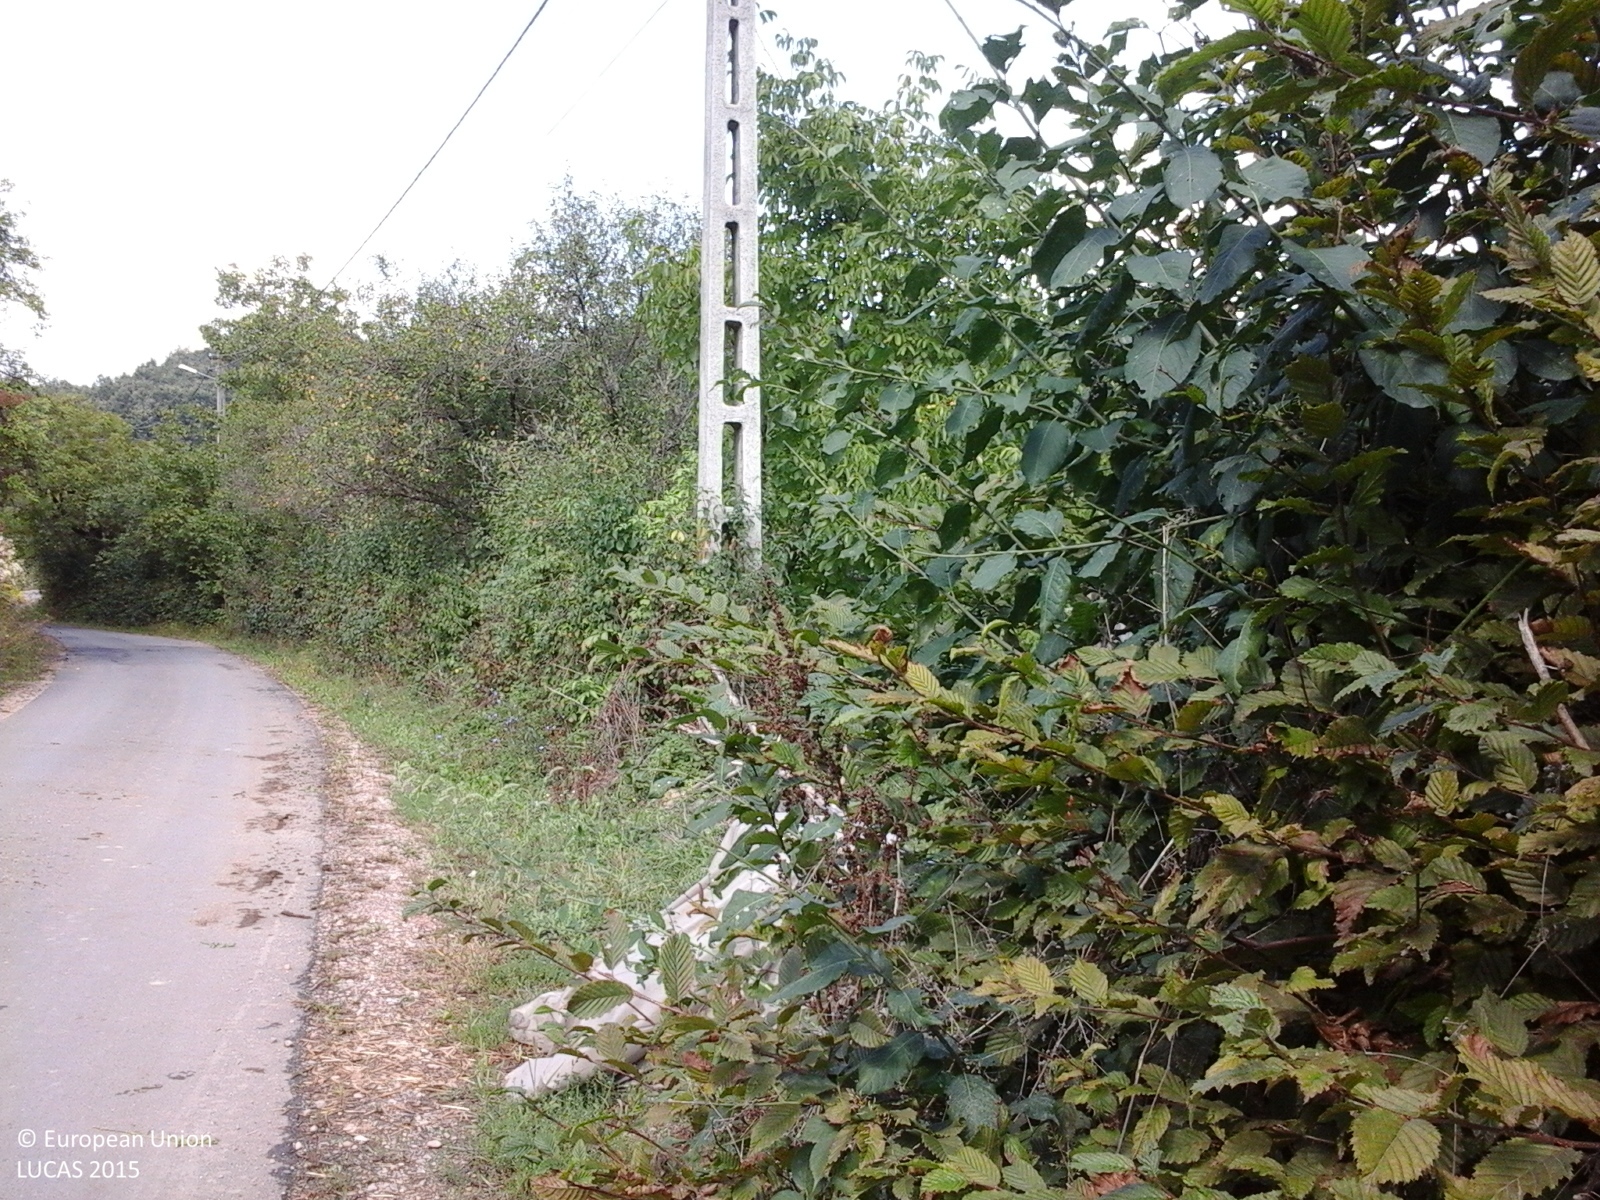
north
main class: Cropland
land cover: Maize
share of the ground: > 75 %
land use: Agriculture (excluding fallow land and kitchen gardens)
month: September
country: RO
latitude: 46.7767
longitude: 22.3752
